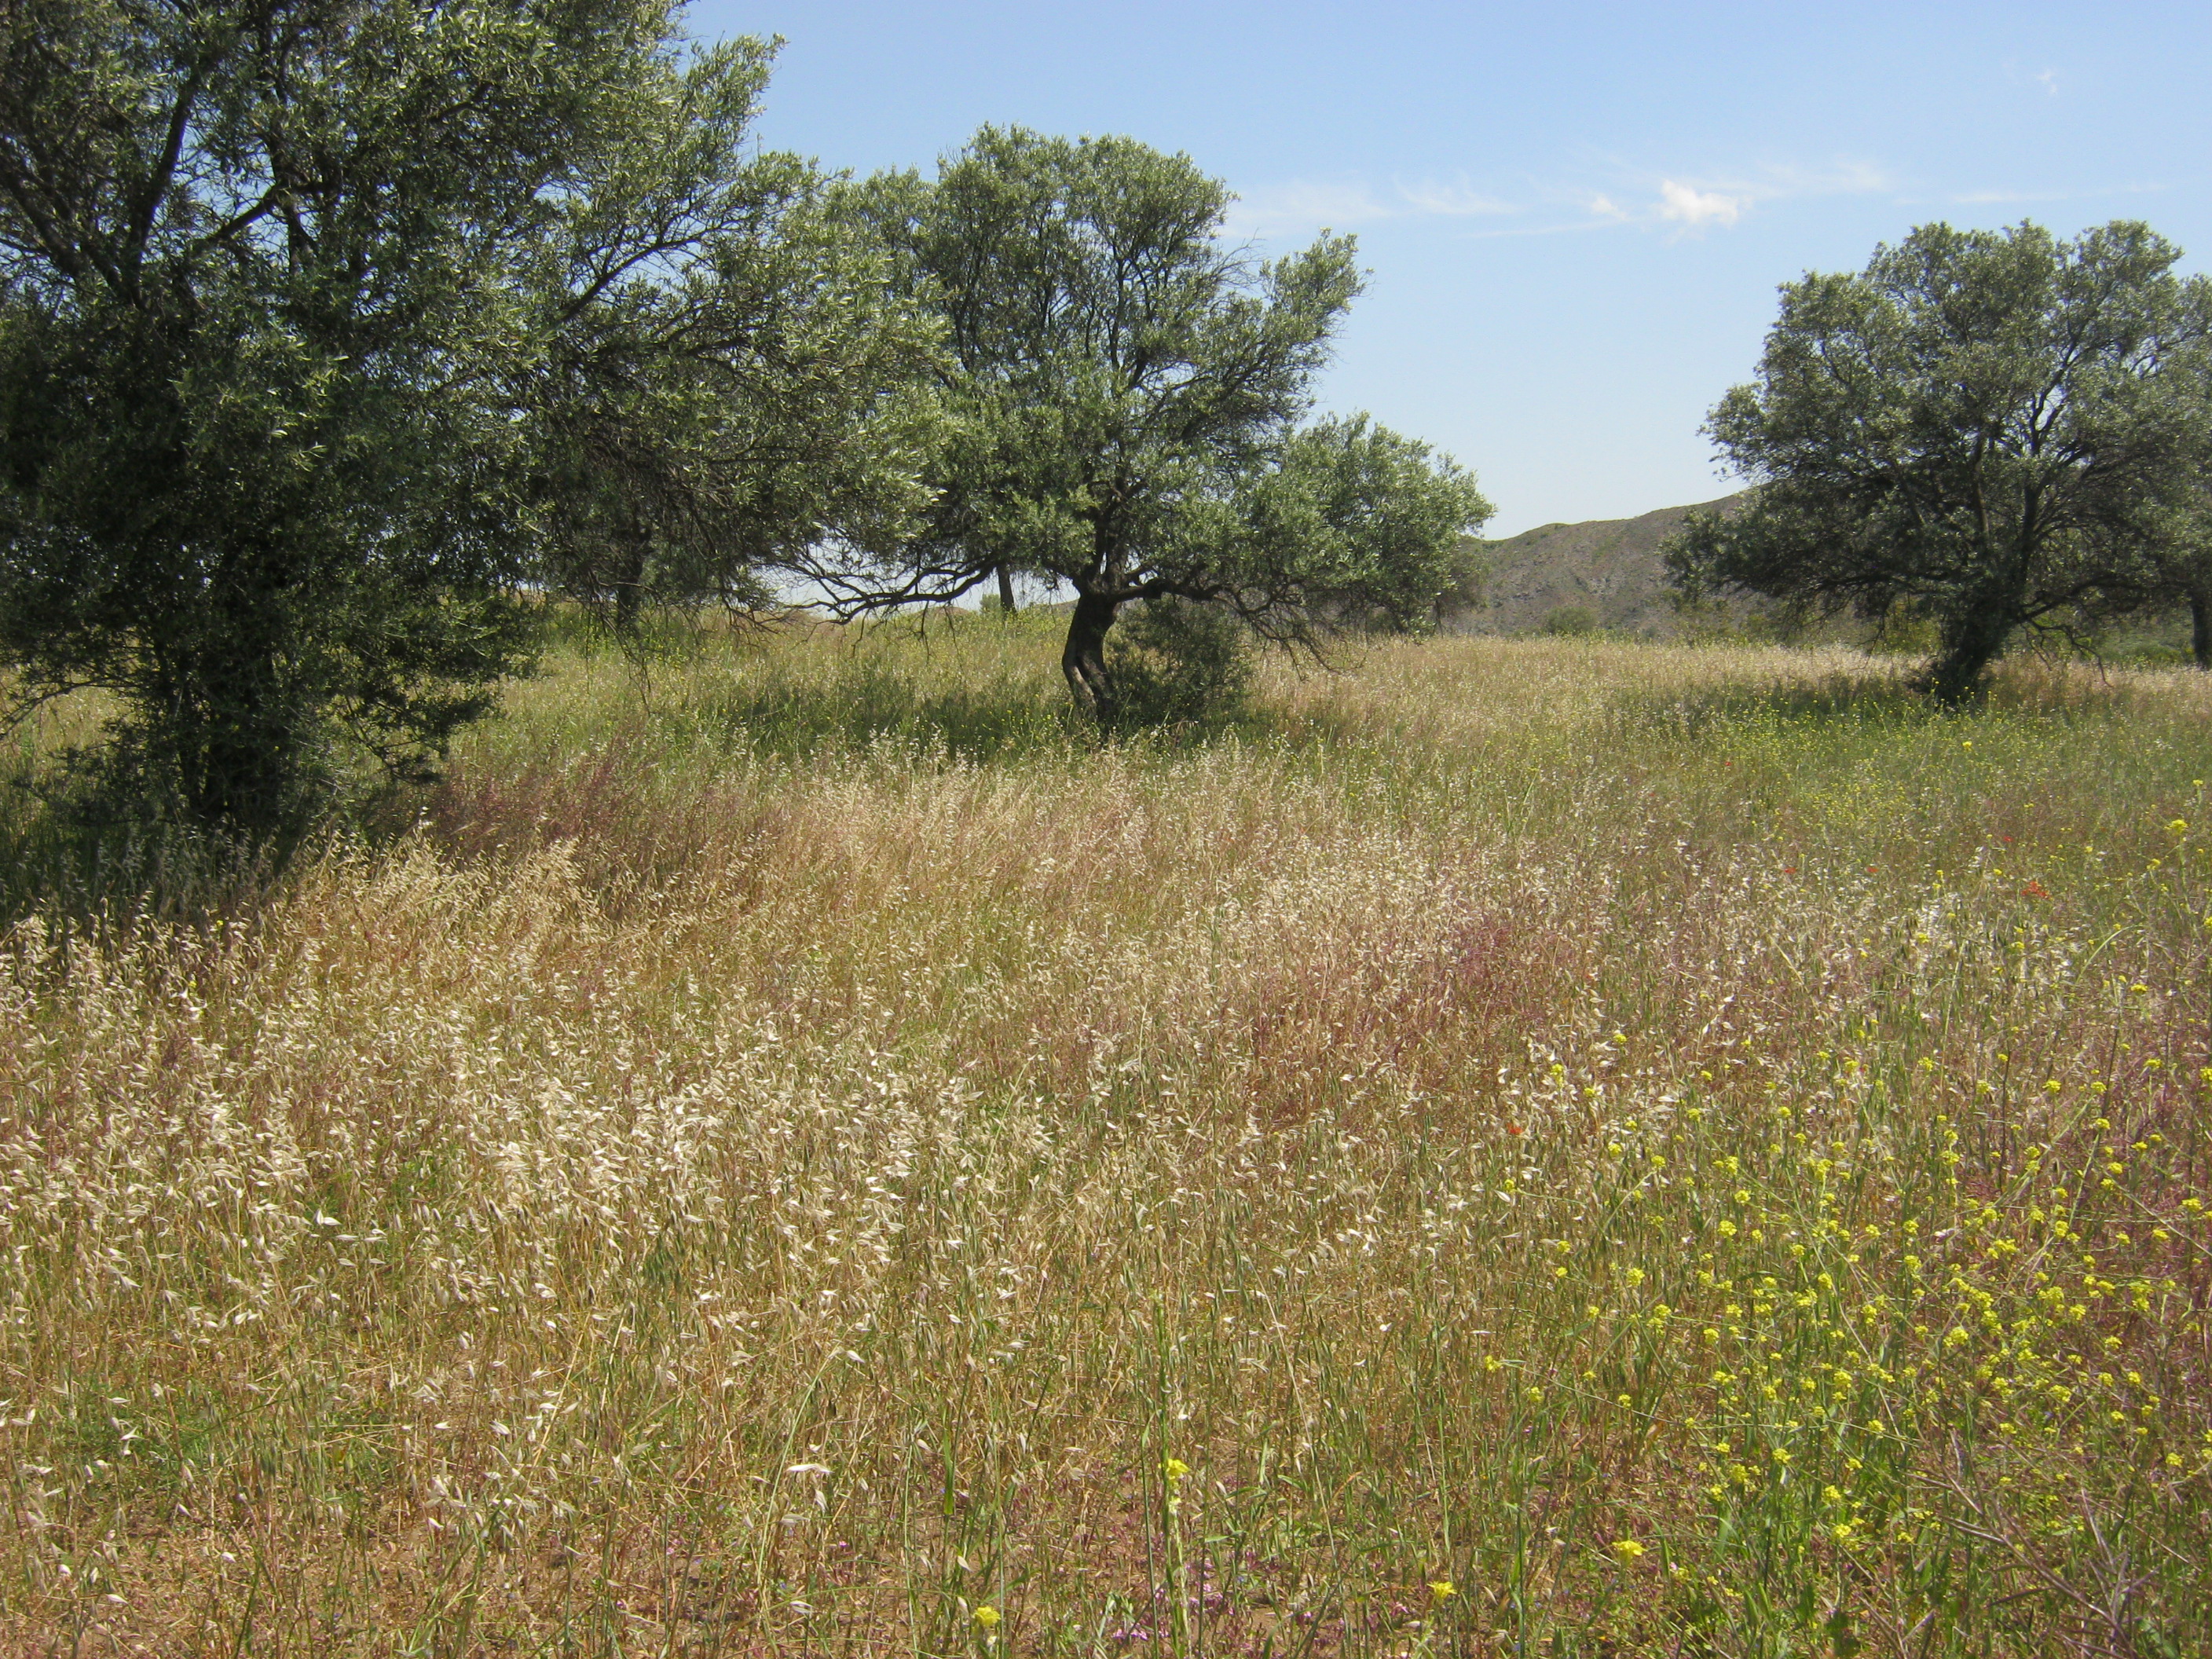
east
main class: Cropland
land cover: Olive groves
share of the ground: 10 - 25 %
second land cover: Grassland without tree/shrub cover
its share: > 75 %
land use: Agriculture (excluding fallow land and kitchen gardens)
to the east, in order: Olive groves; Grassland without tree/shrub cover; Shrubland without tree cover; Rivers and streams; Grassland without tree/shrub cover; Olive groves; Grassland without tree/shrub cover; Rivers and streams; Grassland without tree/shrub cover
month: April
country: CY
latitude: 35.0172
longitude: 33.2990
